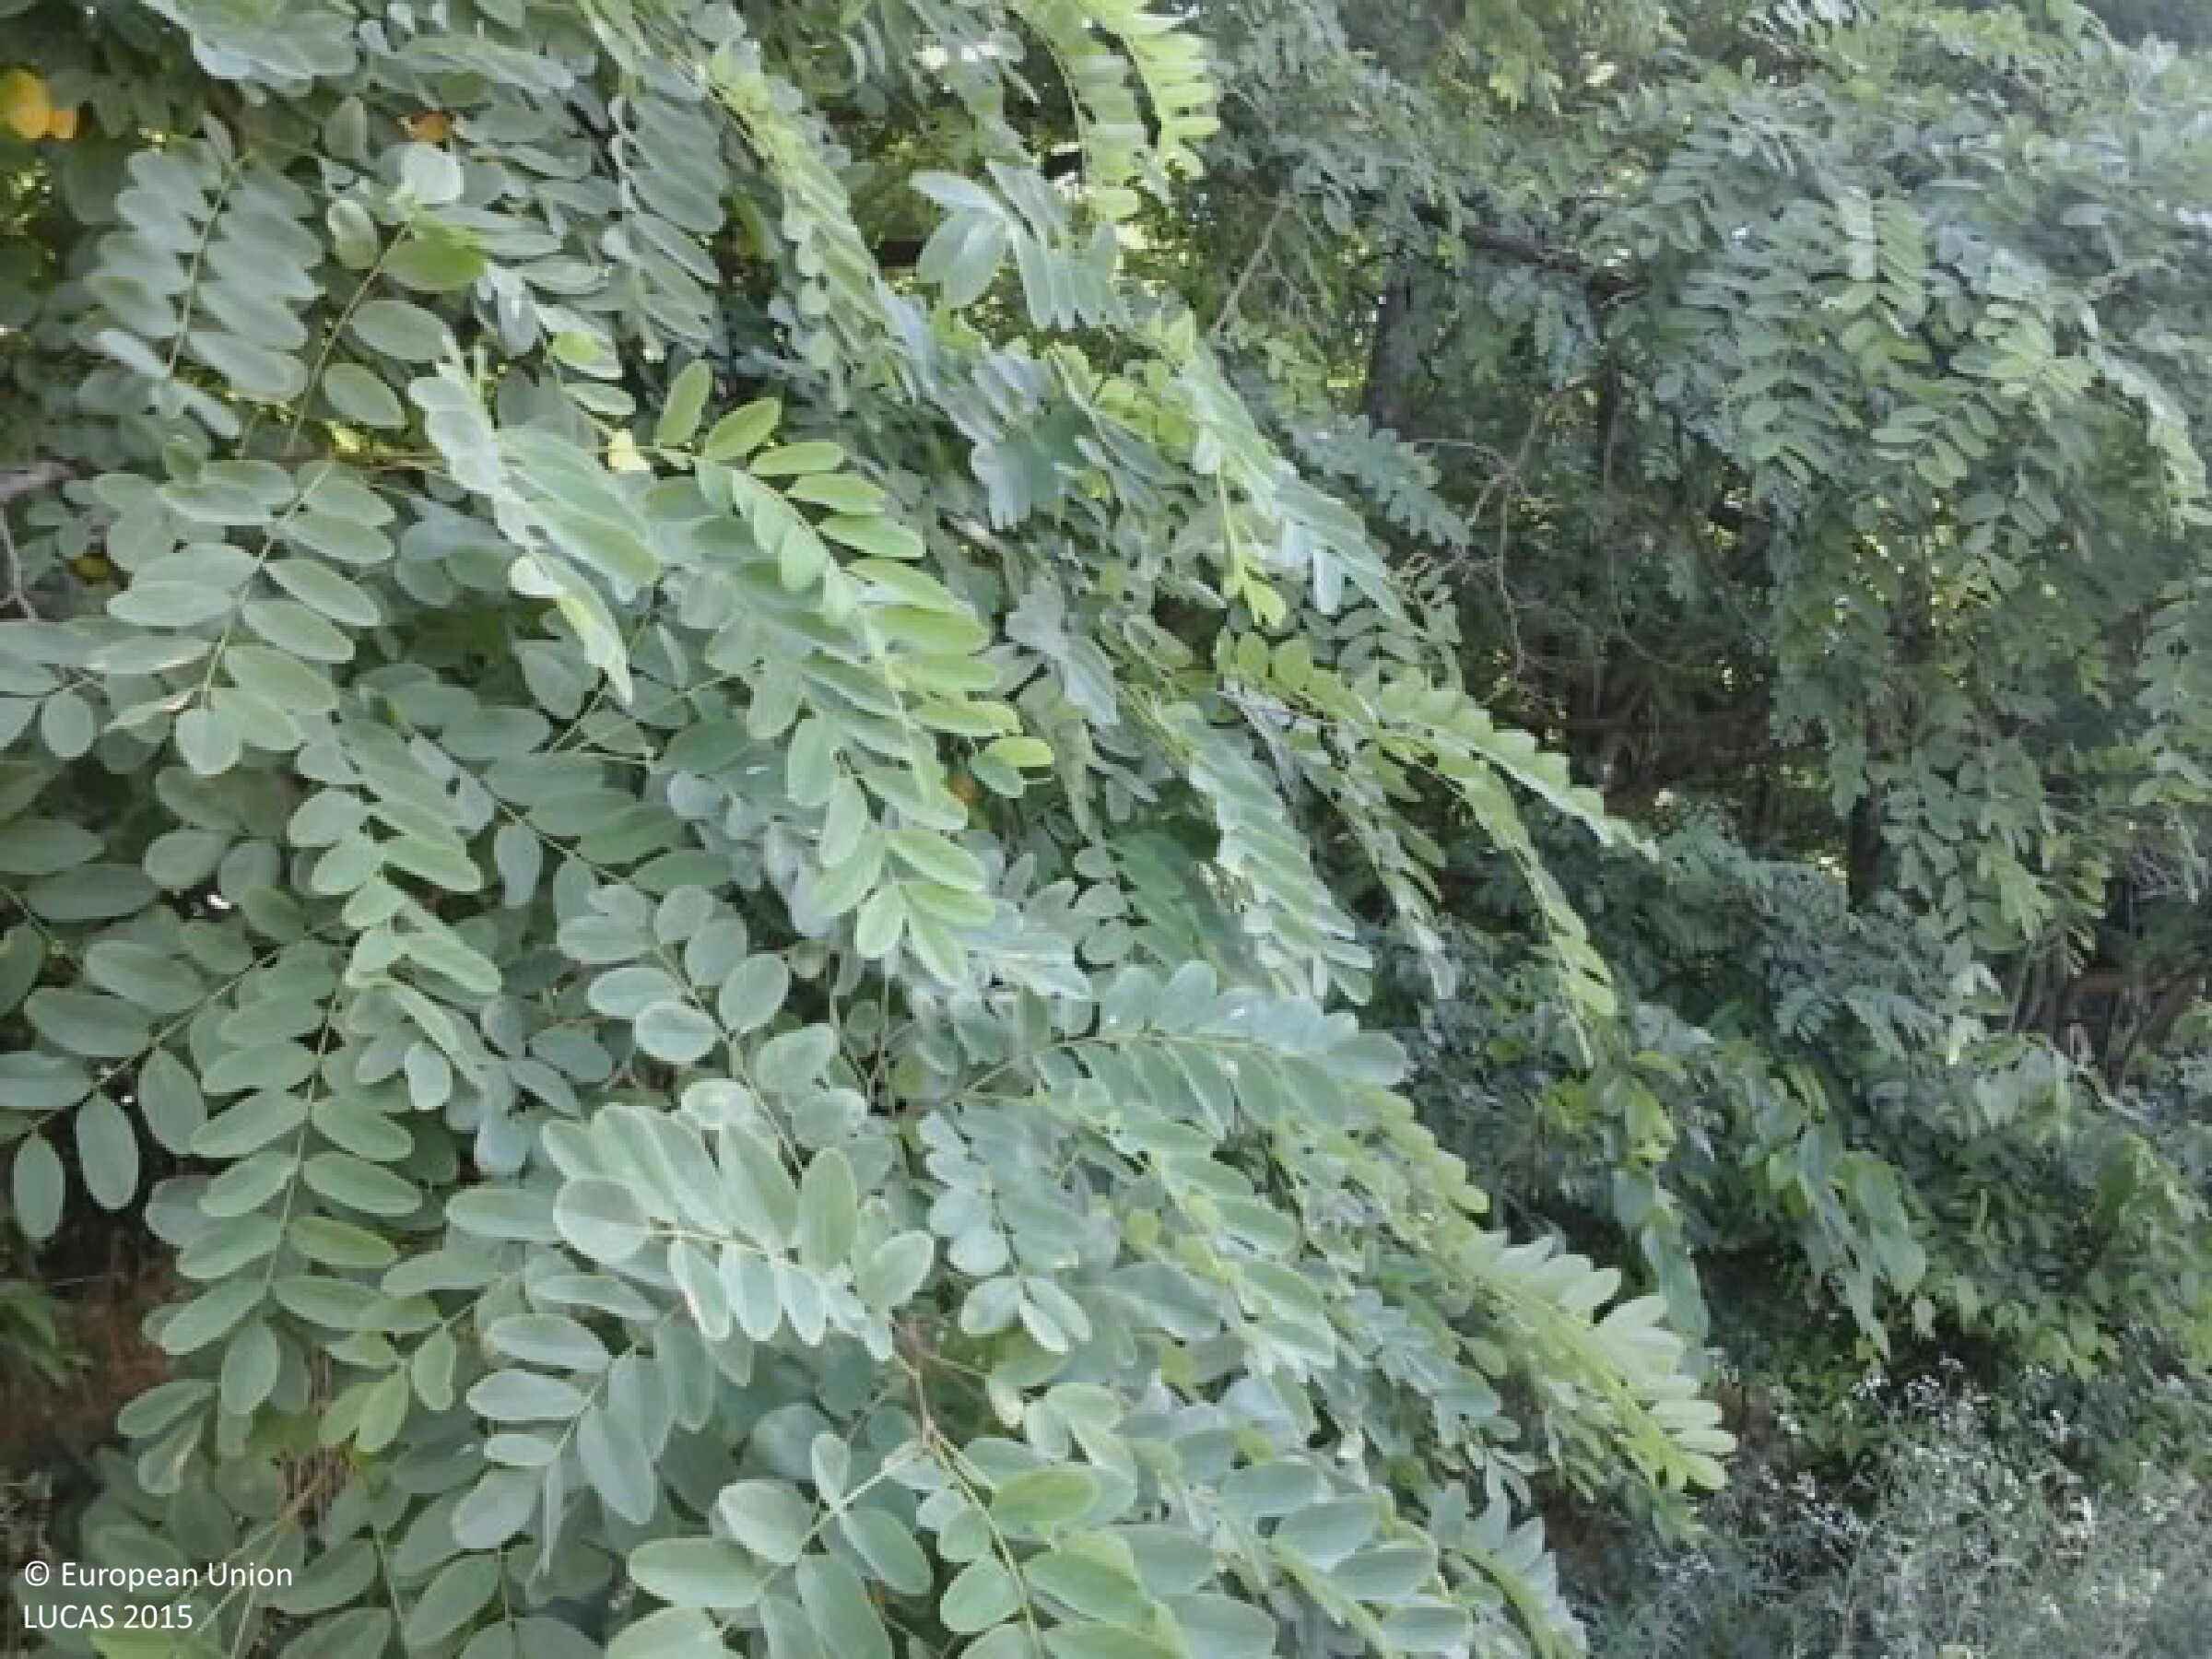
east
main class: Woodland
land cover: Broadleaved woodland
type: exotic forest
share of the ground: > 75 %
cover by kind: broadleaved forest trees 90 %, shrubs 10 %
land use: Forestry
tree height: > 5 m
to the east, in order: Broadleaved woodland; Grass margins; Tracks; Grass margins; Electric lines; Spontaneously vegetated surfaces
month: June
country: HU
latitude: 47.6353
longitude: 19.2432
